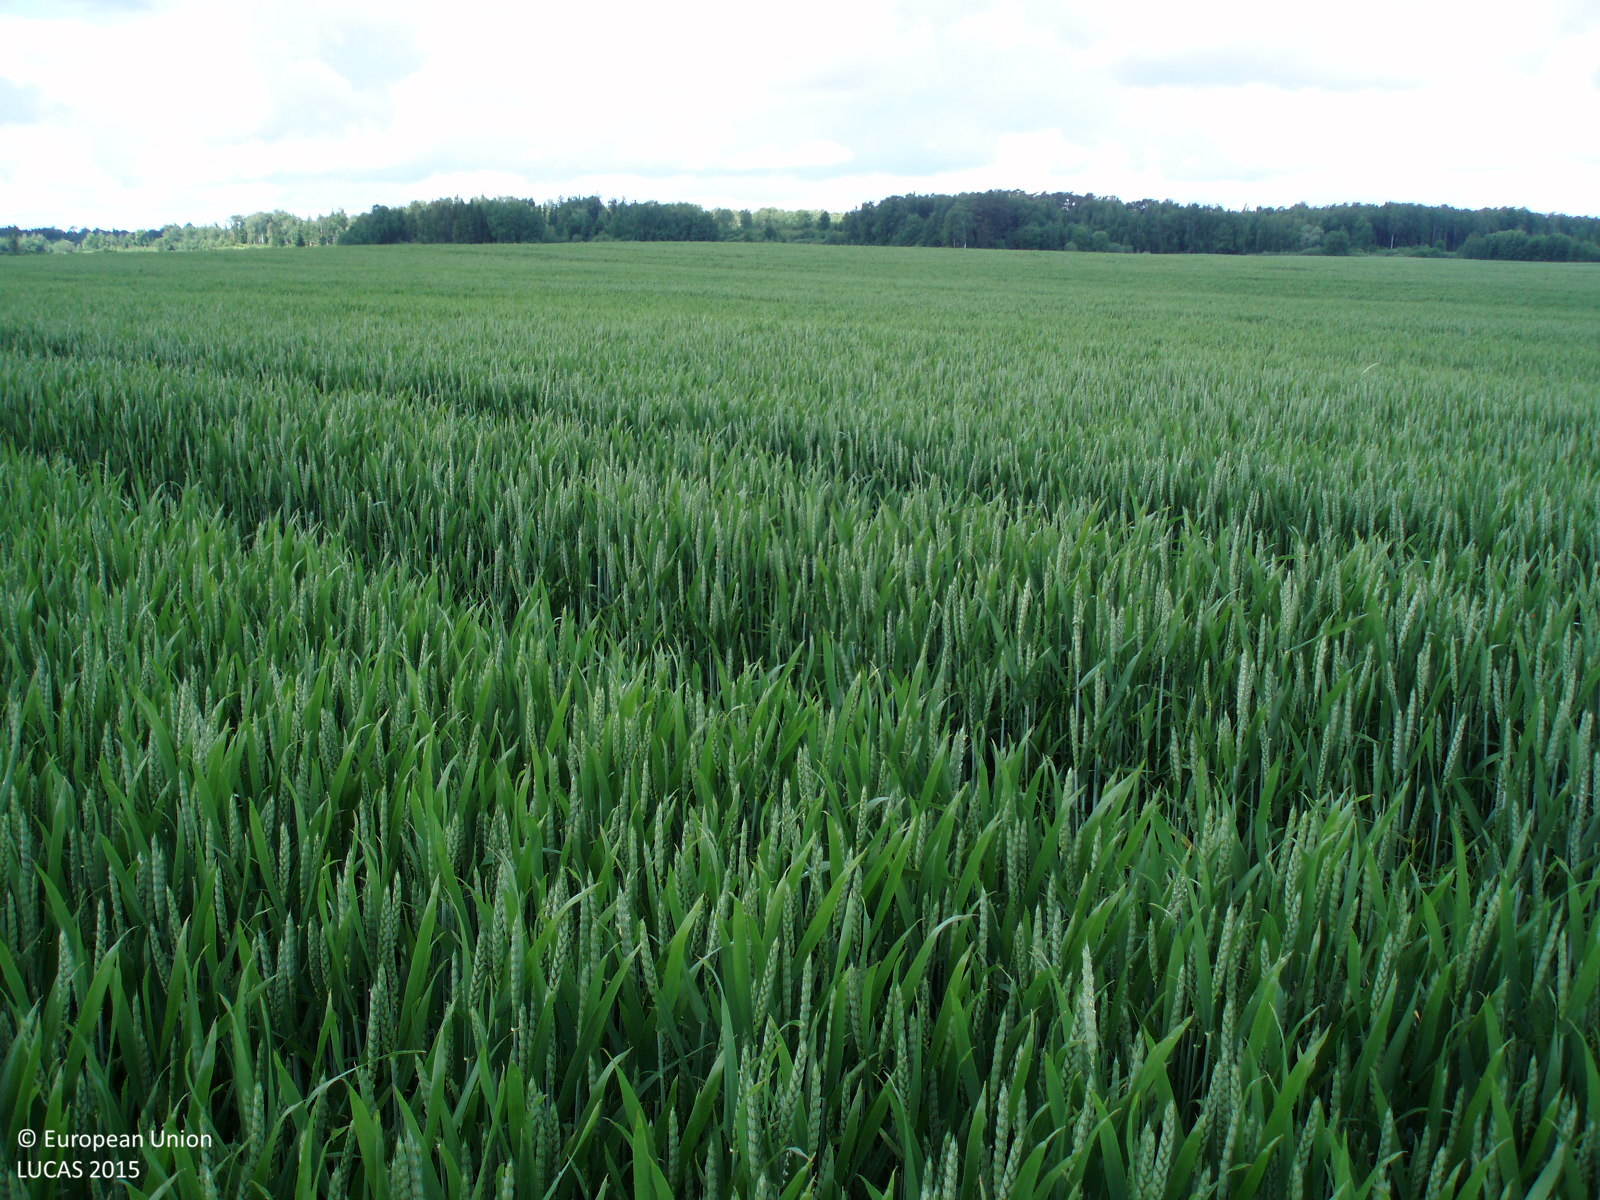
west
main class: Cropland
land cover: Common wheat
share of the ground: > 75 %
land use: Agriculture (excluding fallow land and kitchen gardens)
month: June
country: LT
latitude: 56.2972
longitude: 23.2736
